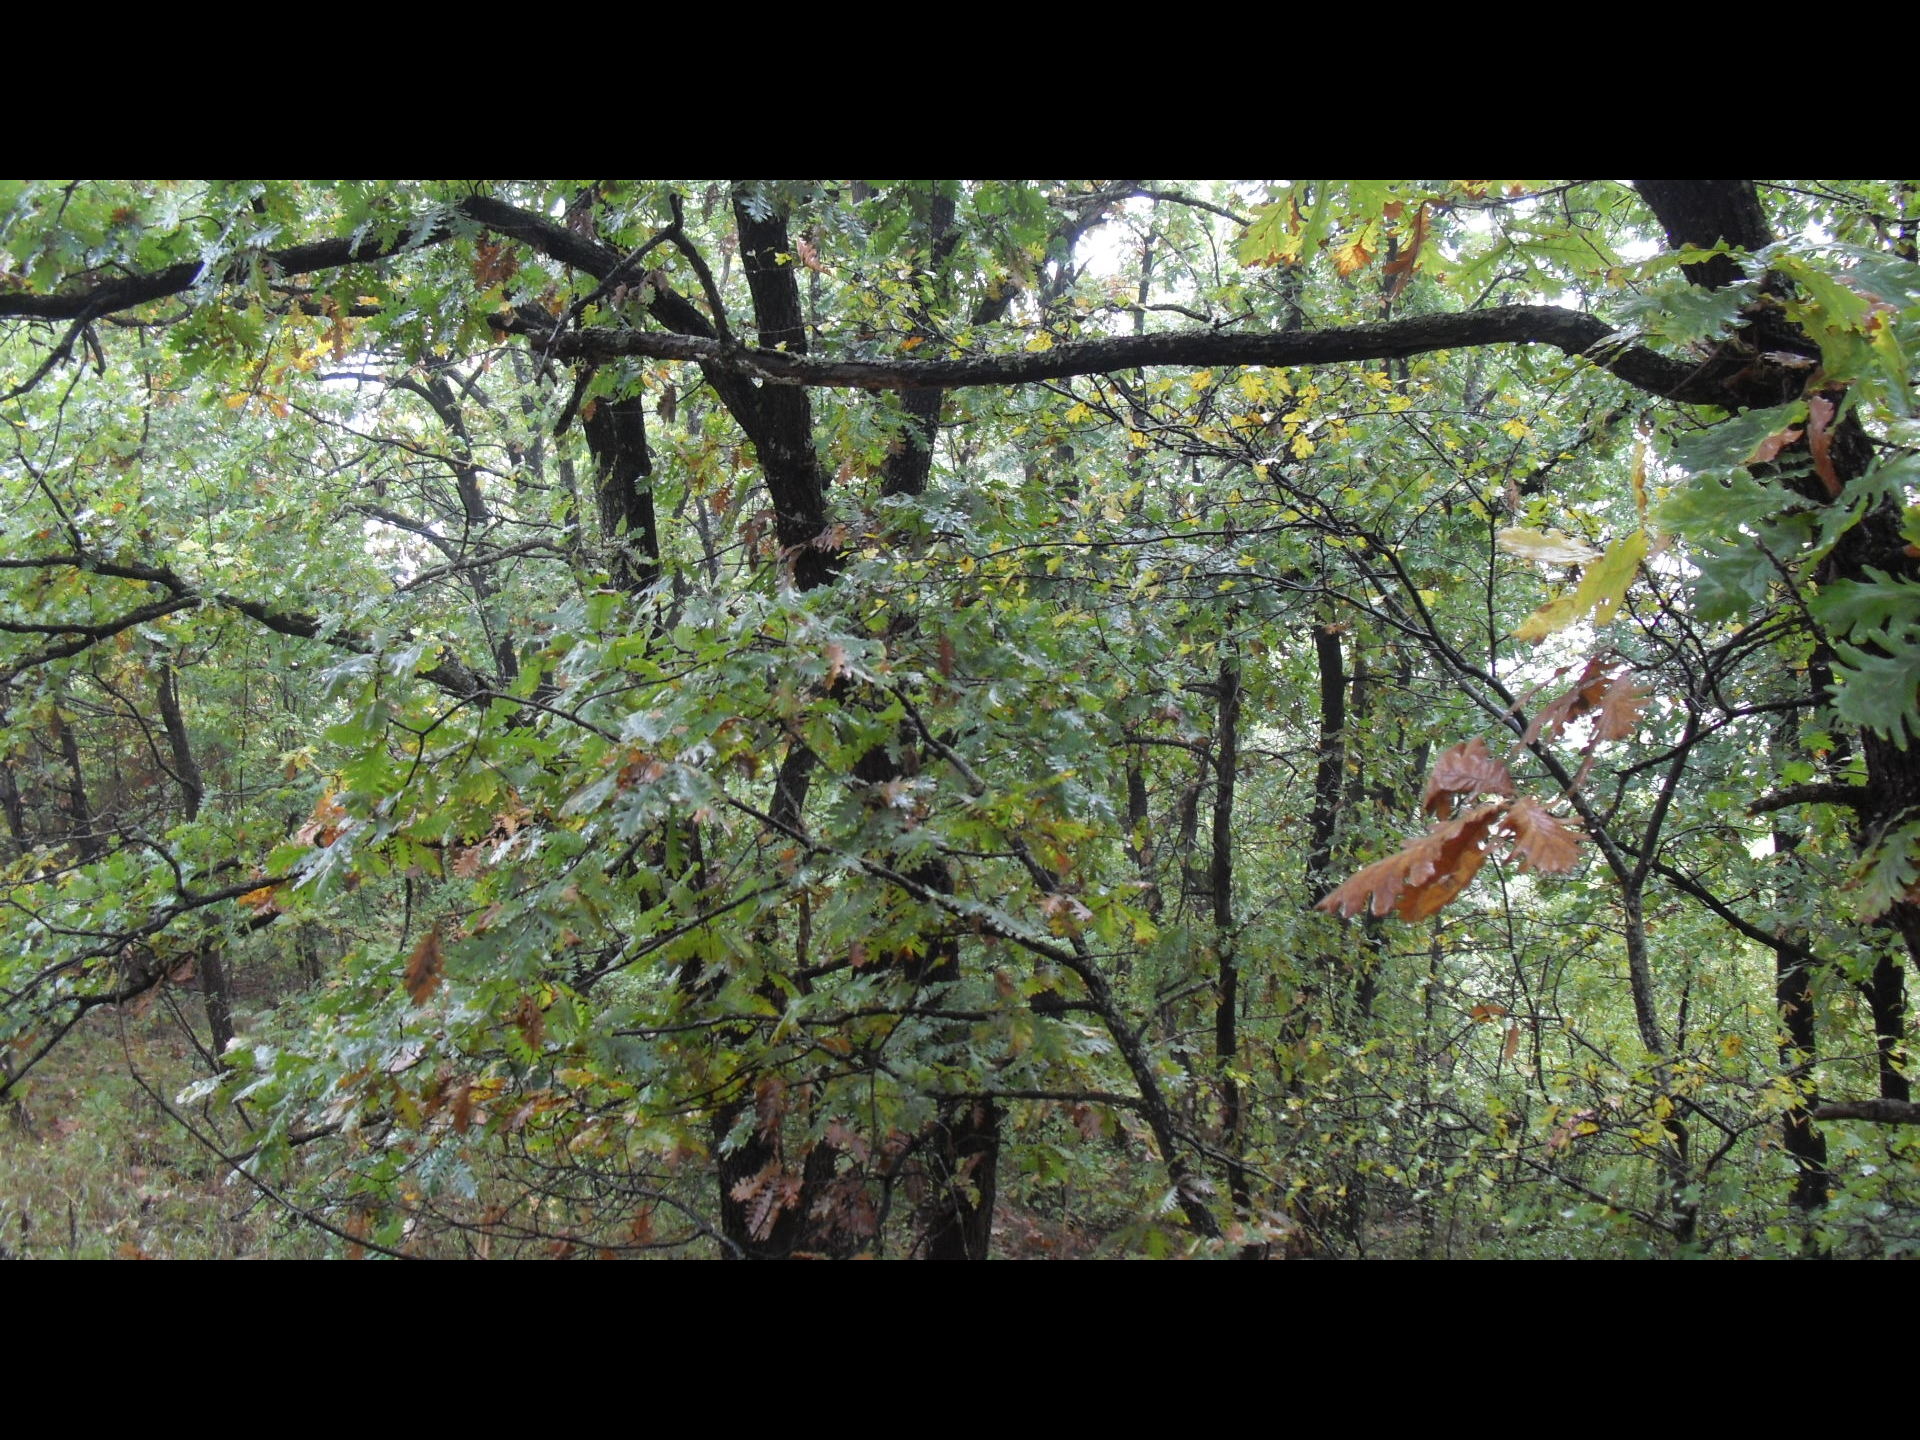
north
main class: Woodland
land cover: Broadleaved woodland
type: mesophytic deciduous forest
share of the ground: > 75 %
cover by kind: broadleaved forest trees 80 %, herbaceous plants 15 %, shrubs 5 %
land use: Forestry
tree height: > 5 m
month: October
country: BG
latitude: 43.6114
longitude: 22.6340
